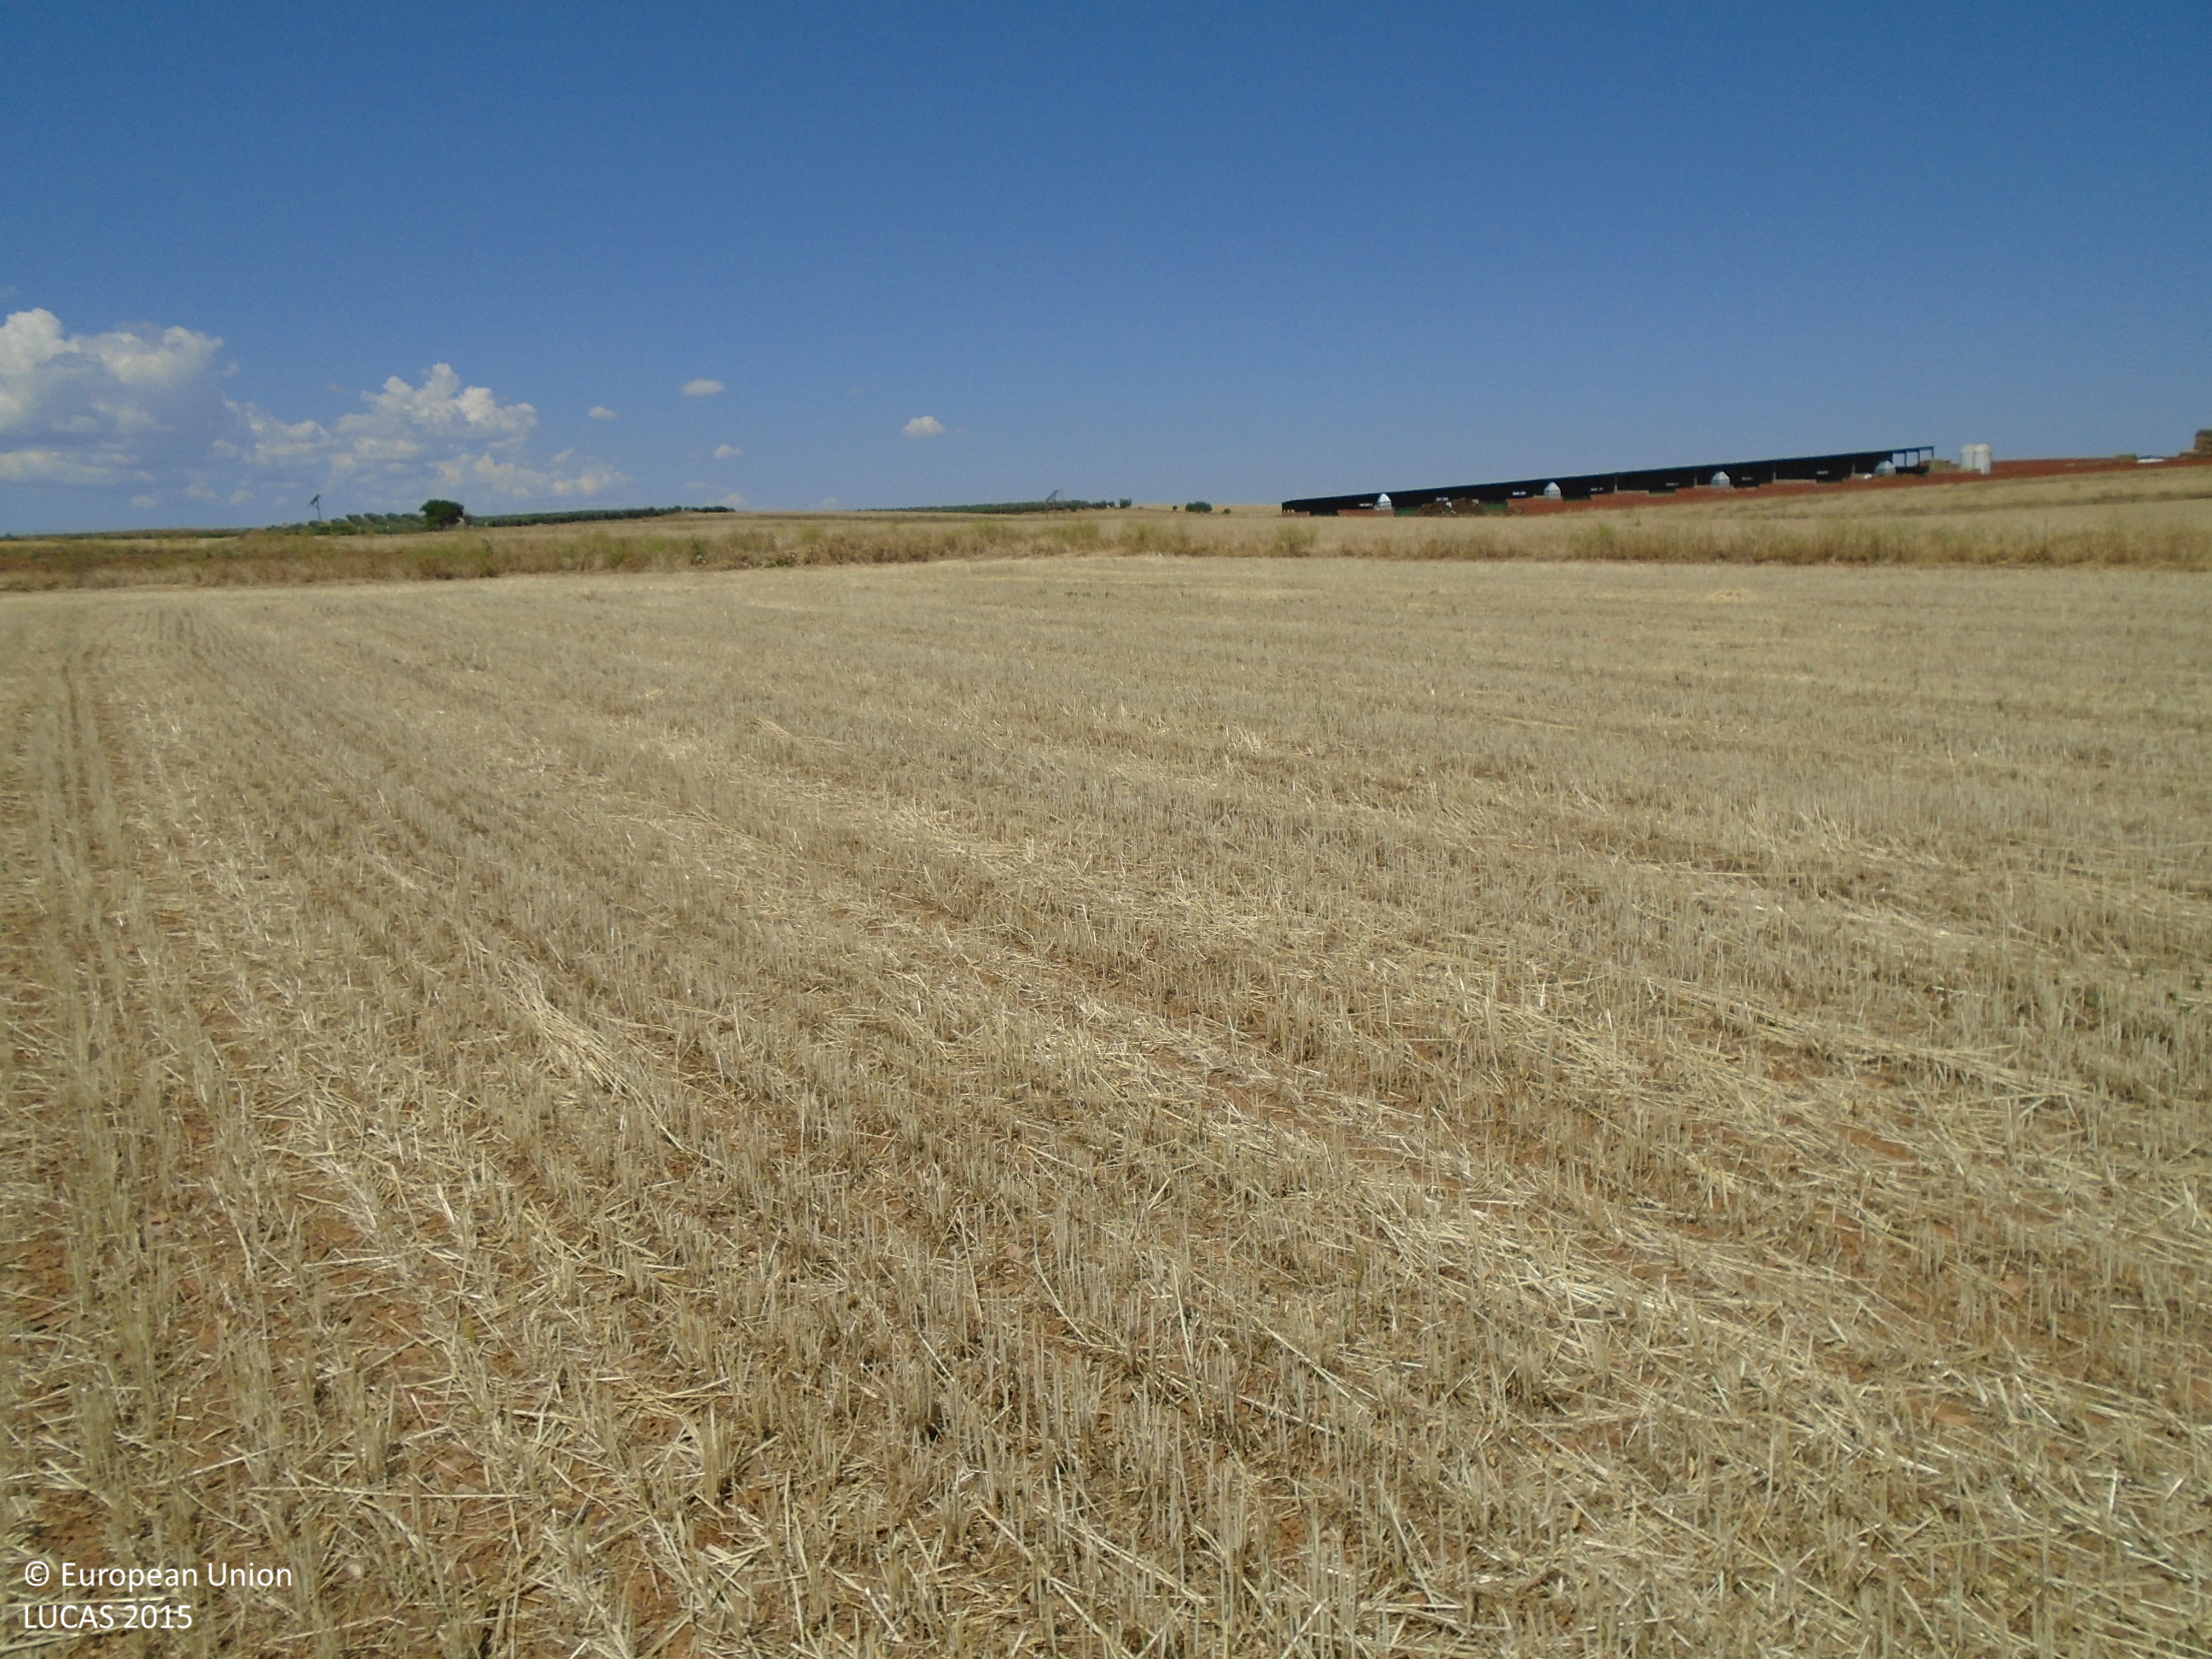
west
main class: Cropland
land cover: Barley
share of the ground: > 75 %
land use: Agriculture (excluding fallow land and kitchen gardens)
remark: Harvested field
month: June
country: ES
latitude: 39.6903
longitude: -4.1786
